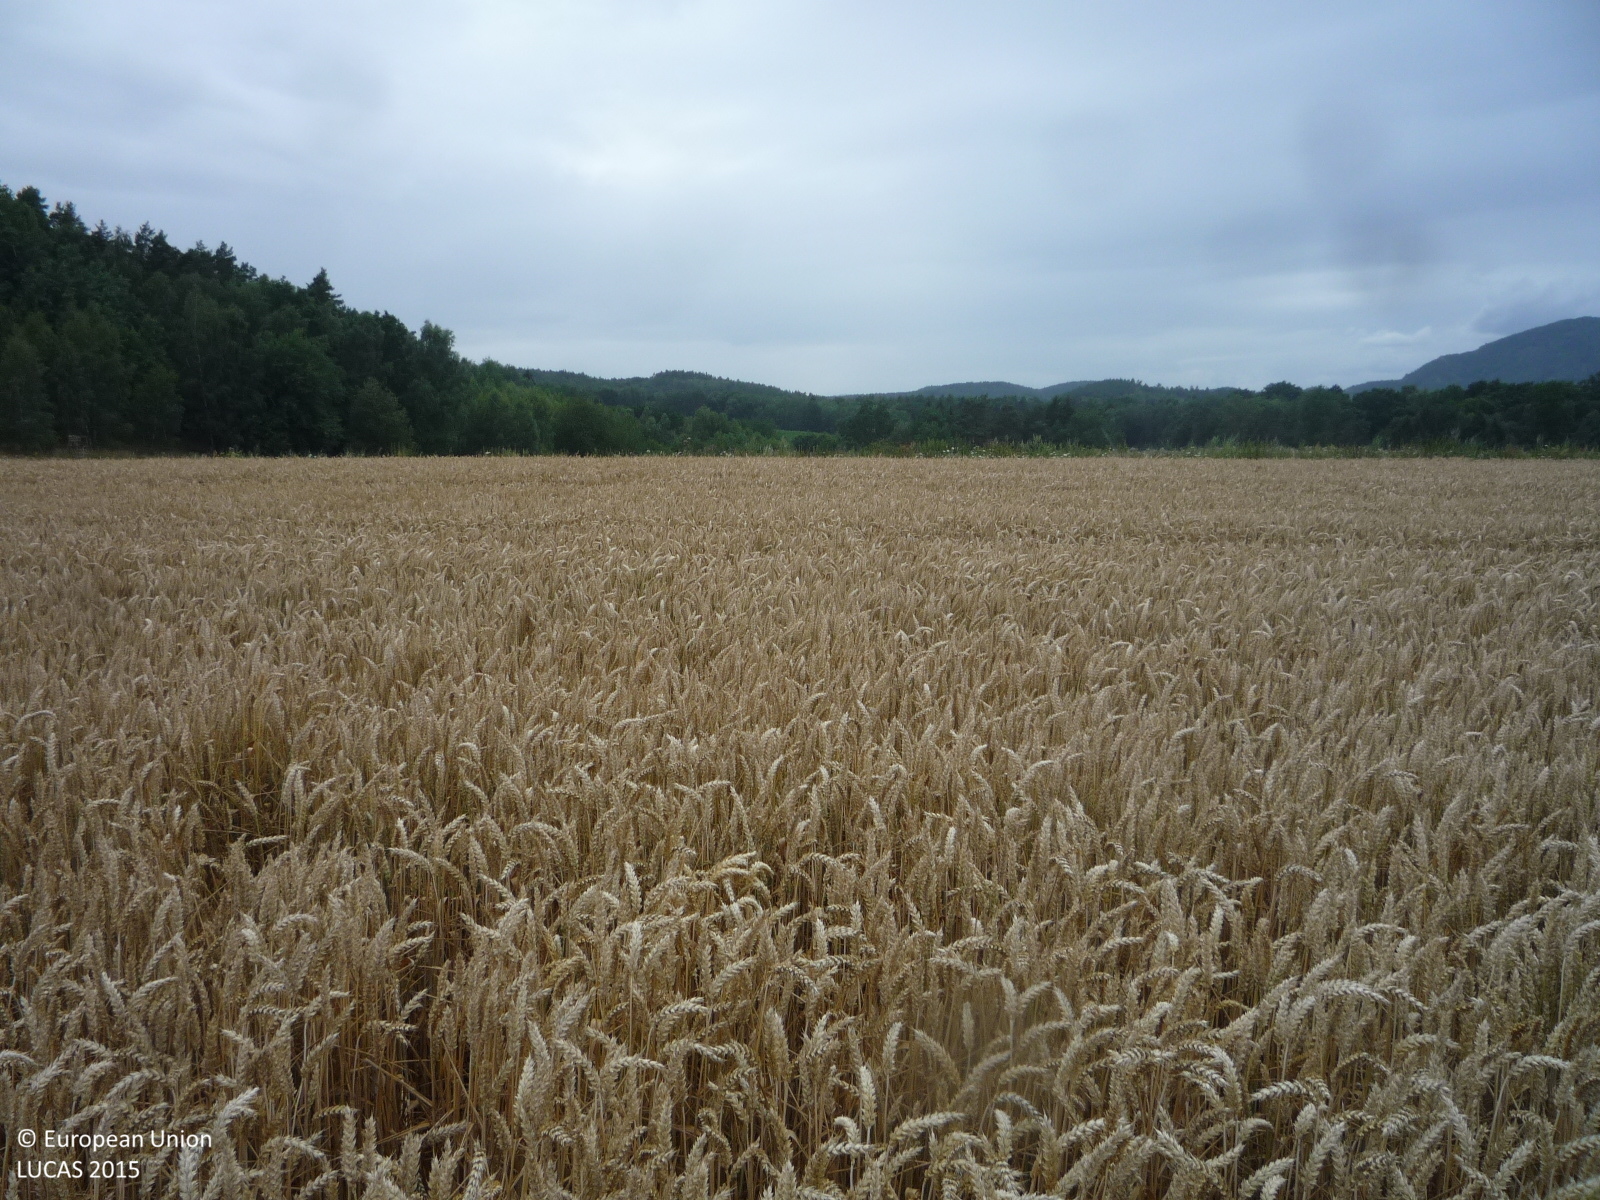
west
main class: Cropland
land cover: Common wheat
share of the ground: > 75 %
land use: Agriculture (excluding fallow land and kitchen gardens)
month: July
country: CZ
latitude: 50.5814
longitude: 14.5070
